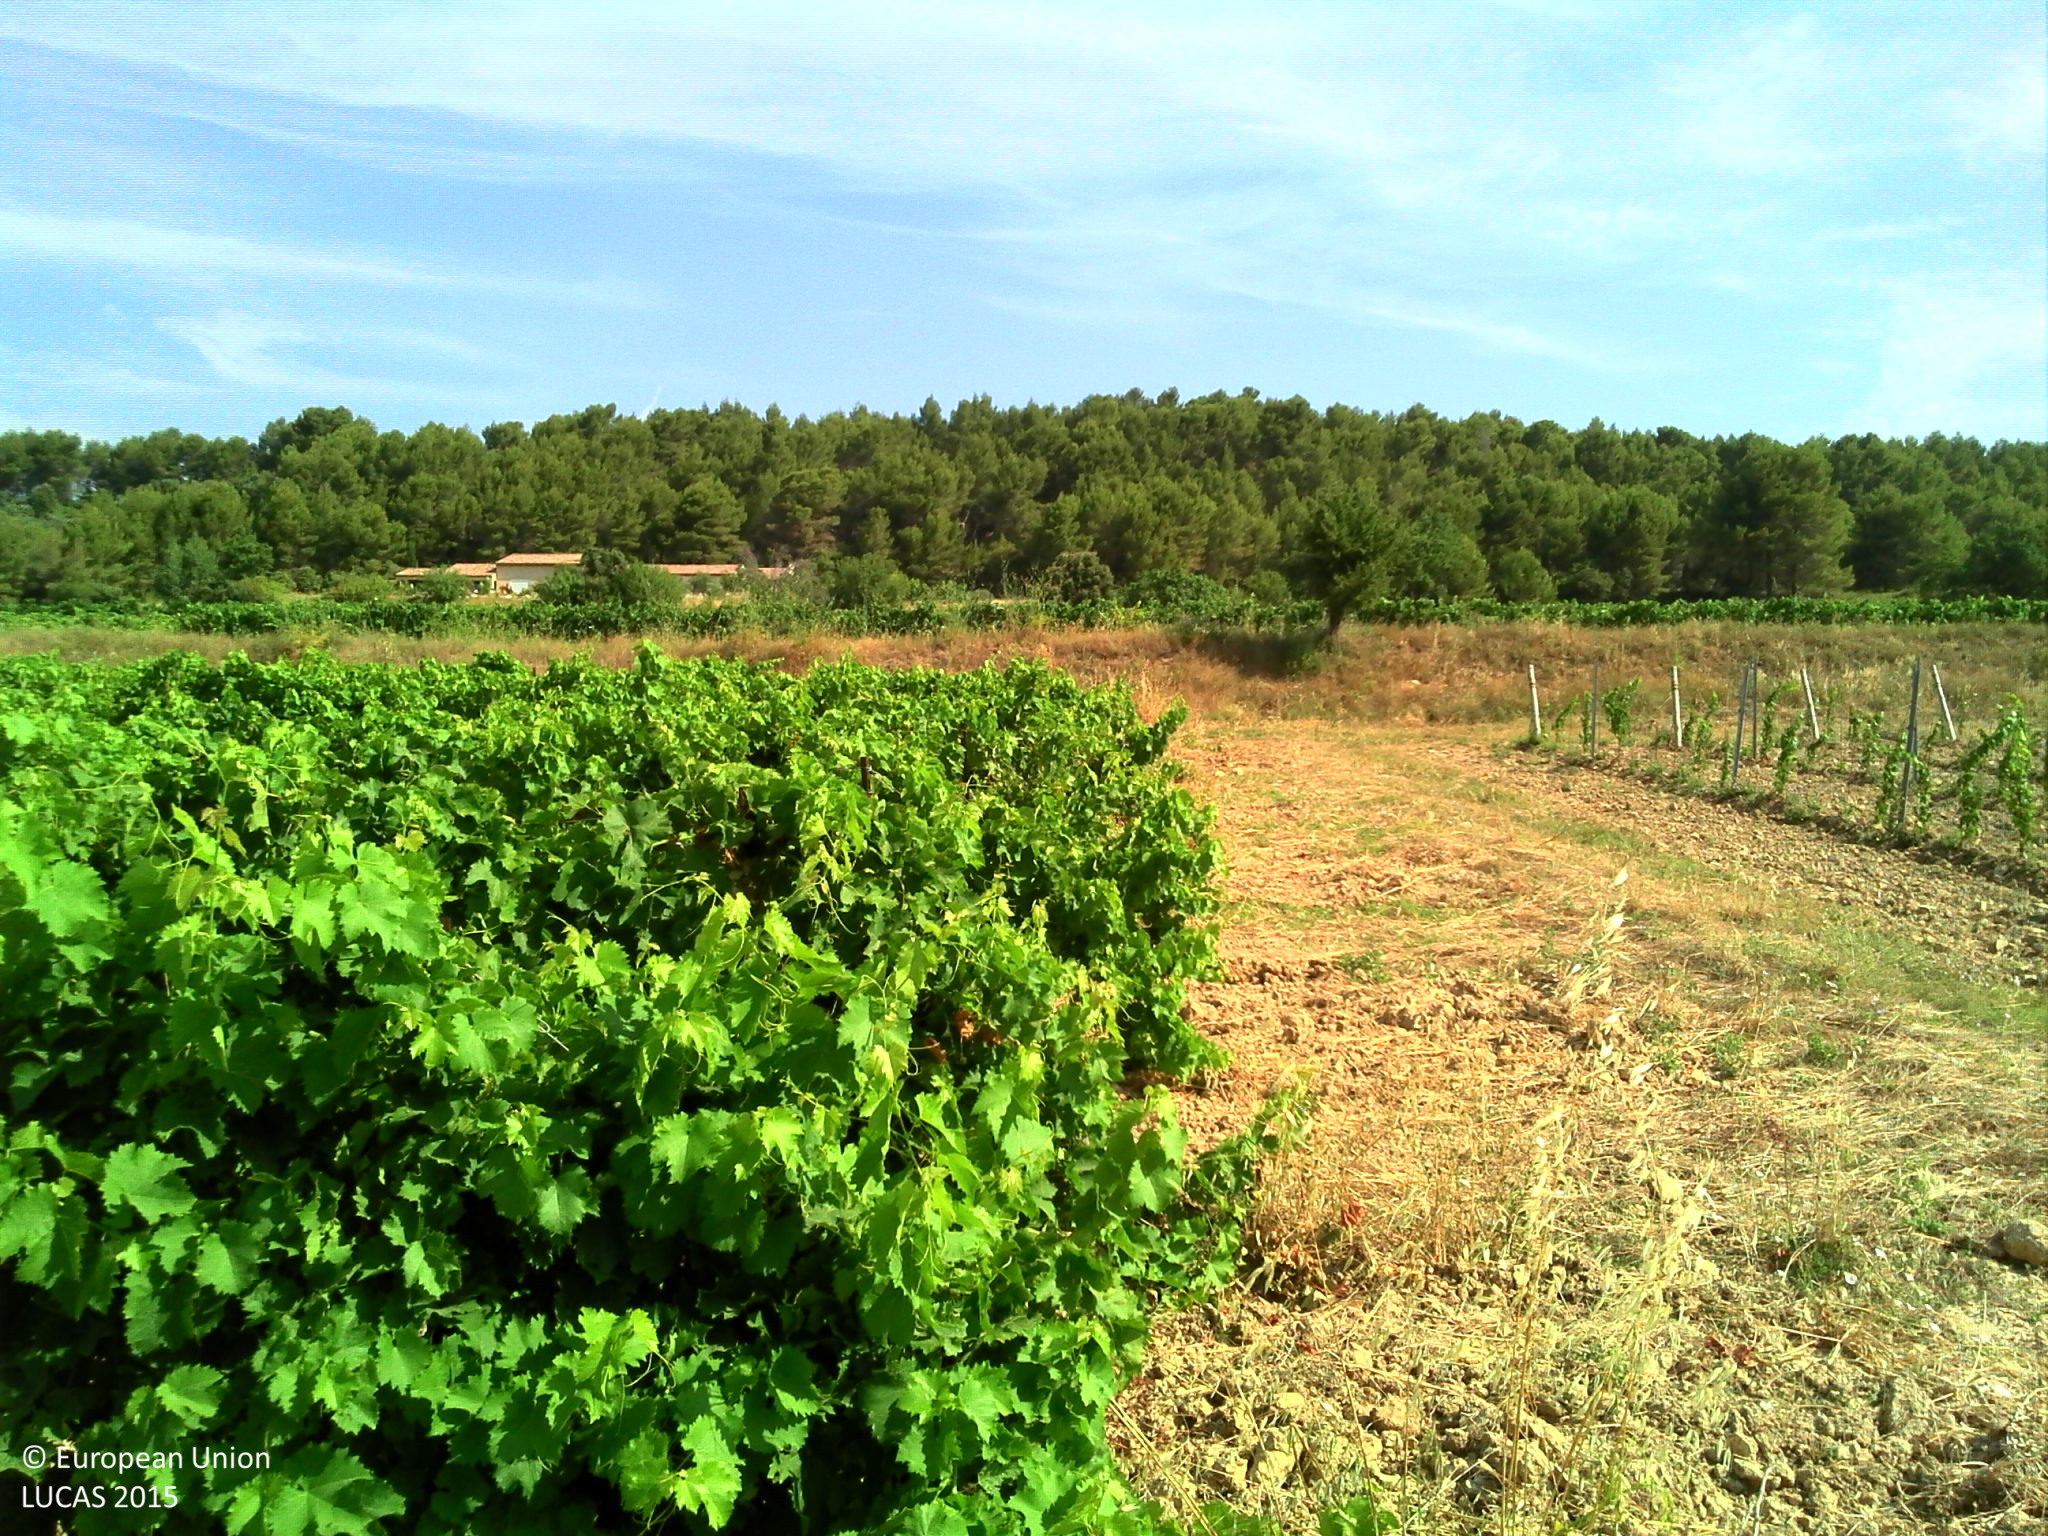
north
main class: Cropland
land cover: Vineyards
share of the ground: 25 - 50 %
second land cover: Other bare soil
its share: > 75 %
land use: Agriculture (excluding fallow land and kitchen gardens)
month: July
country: FR
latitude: 43.6953
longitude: 5.5548
